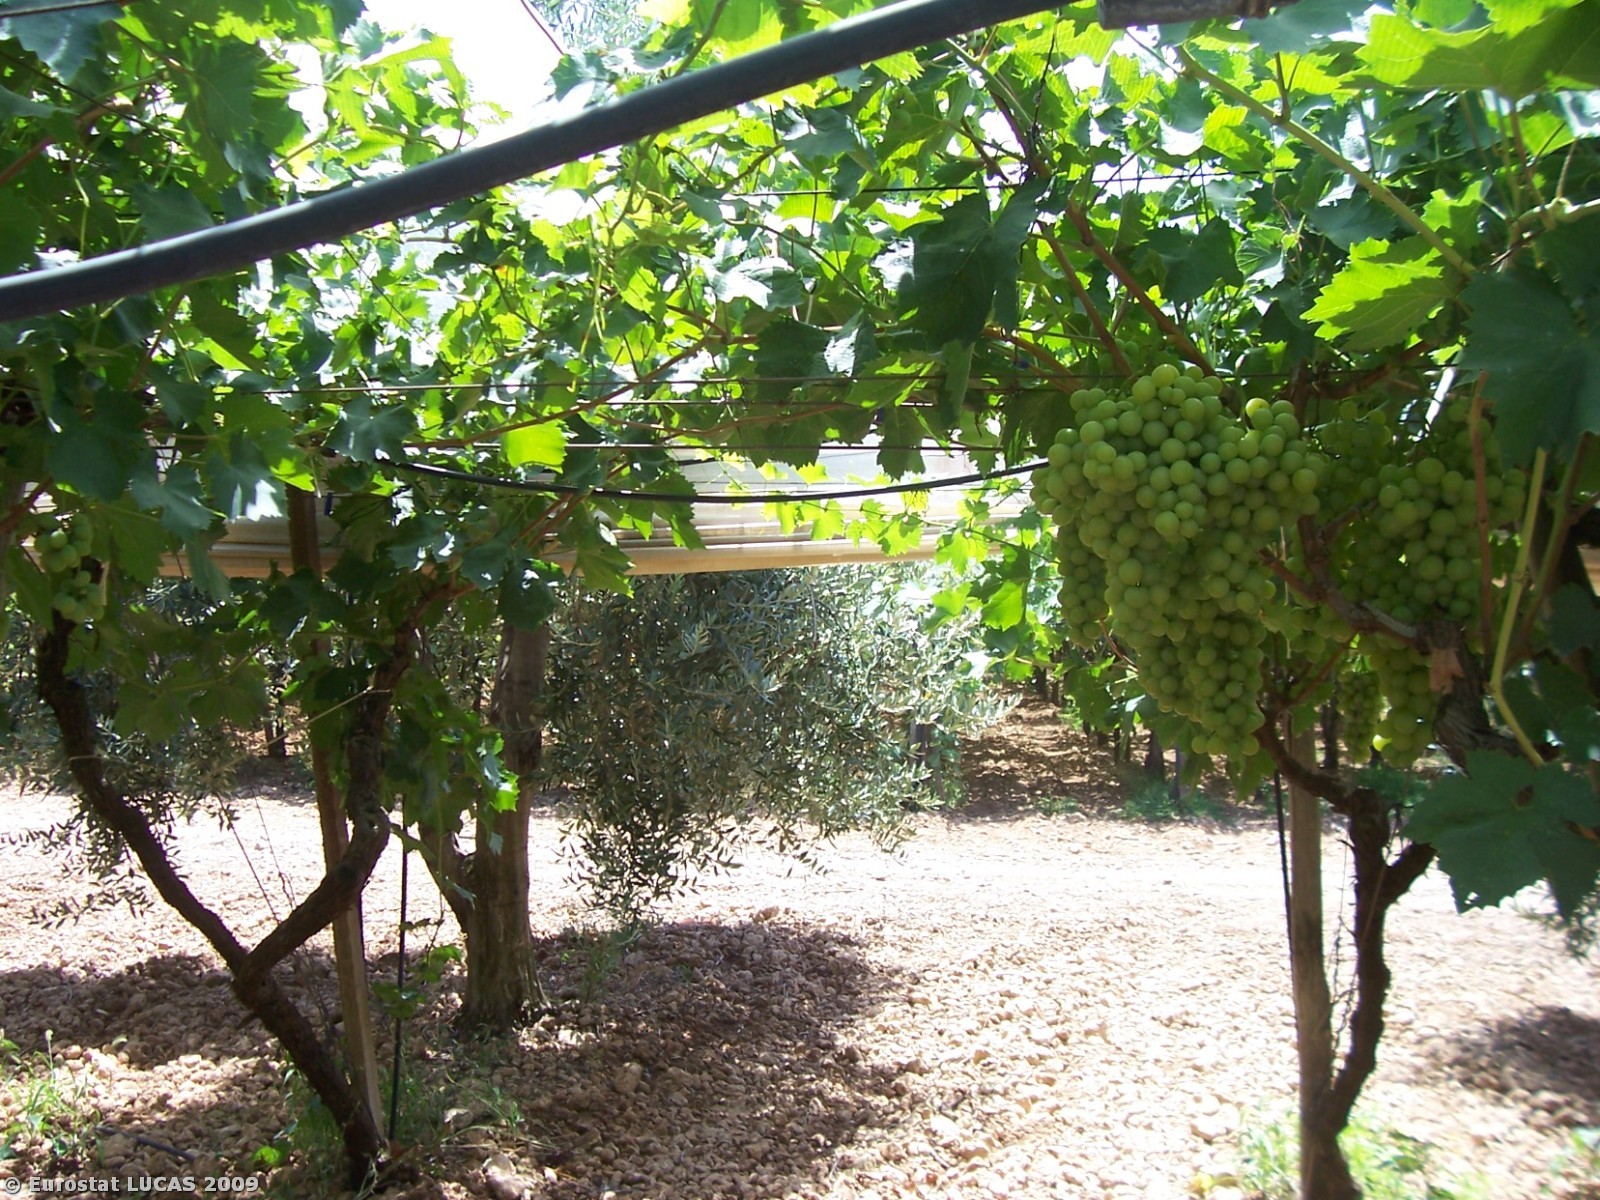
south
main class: Cropland
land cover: Vineyards
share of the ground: > 75 %
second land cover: Bare land
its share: > 75 %
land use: Agriculture (excluding fallow land and kitchen gardens)
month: July
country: IT
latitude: 40.6155
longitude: 17.0094
